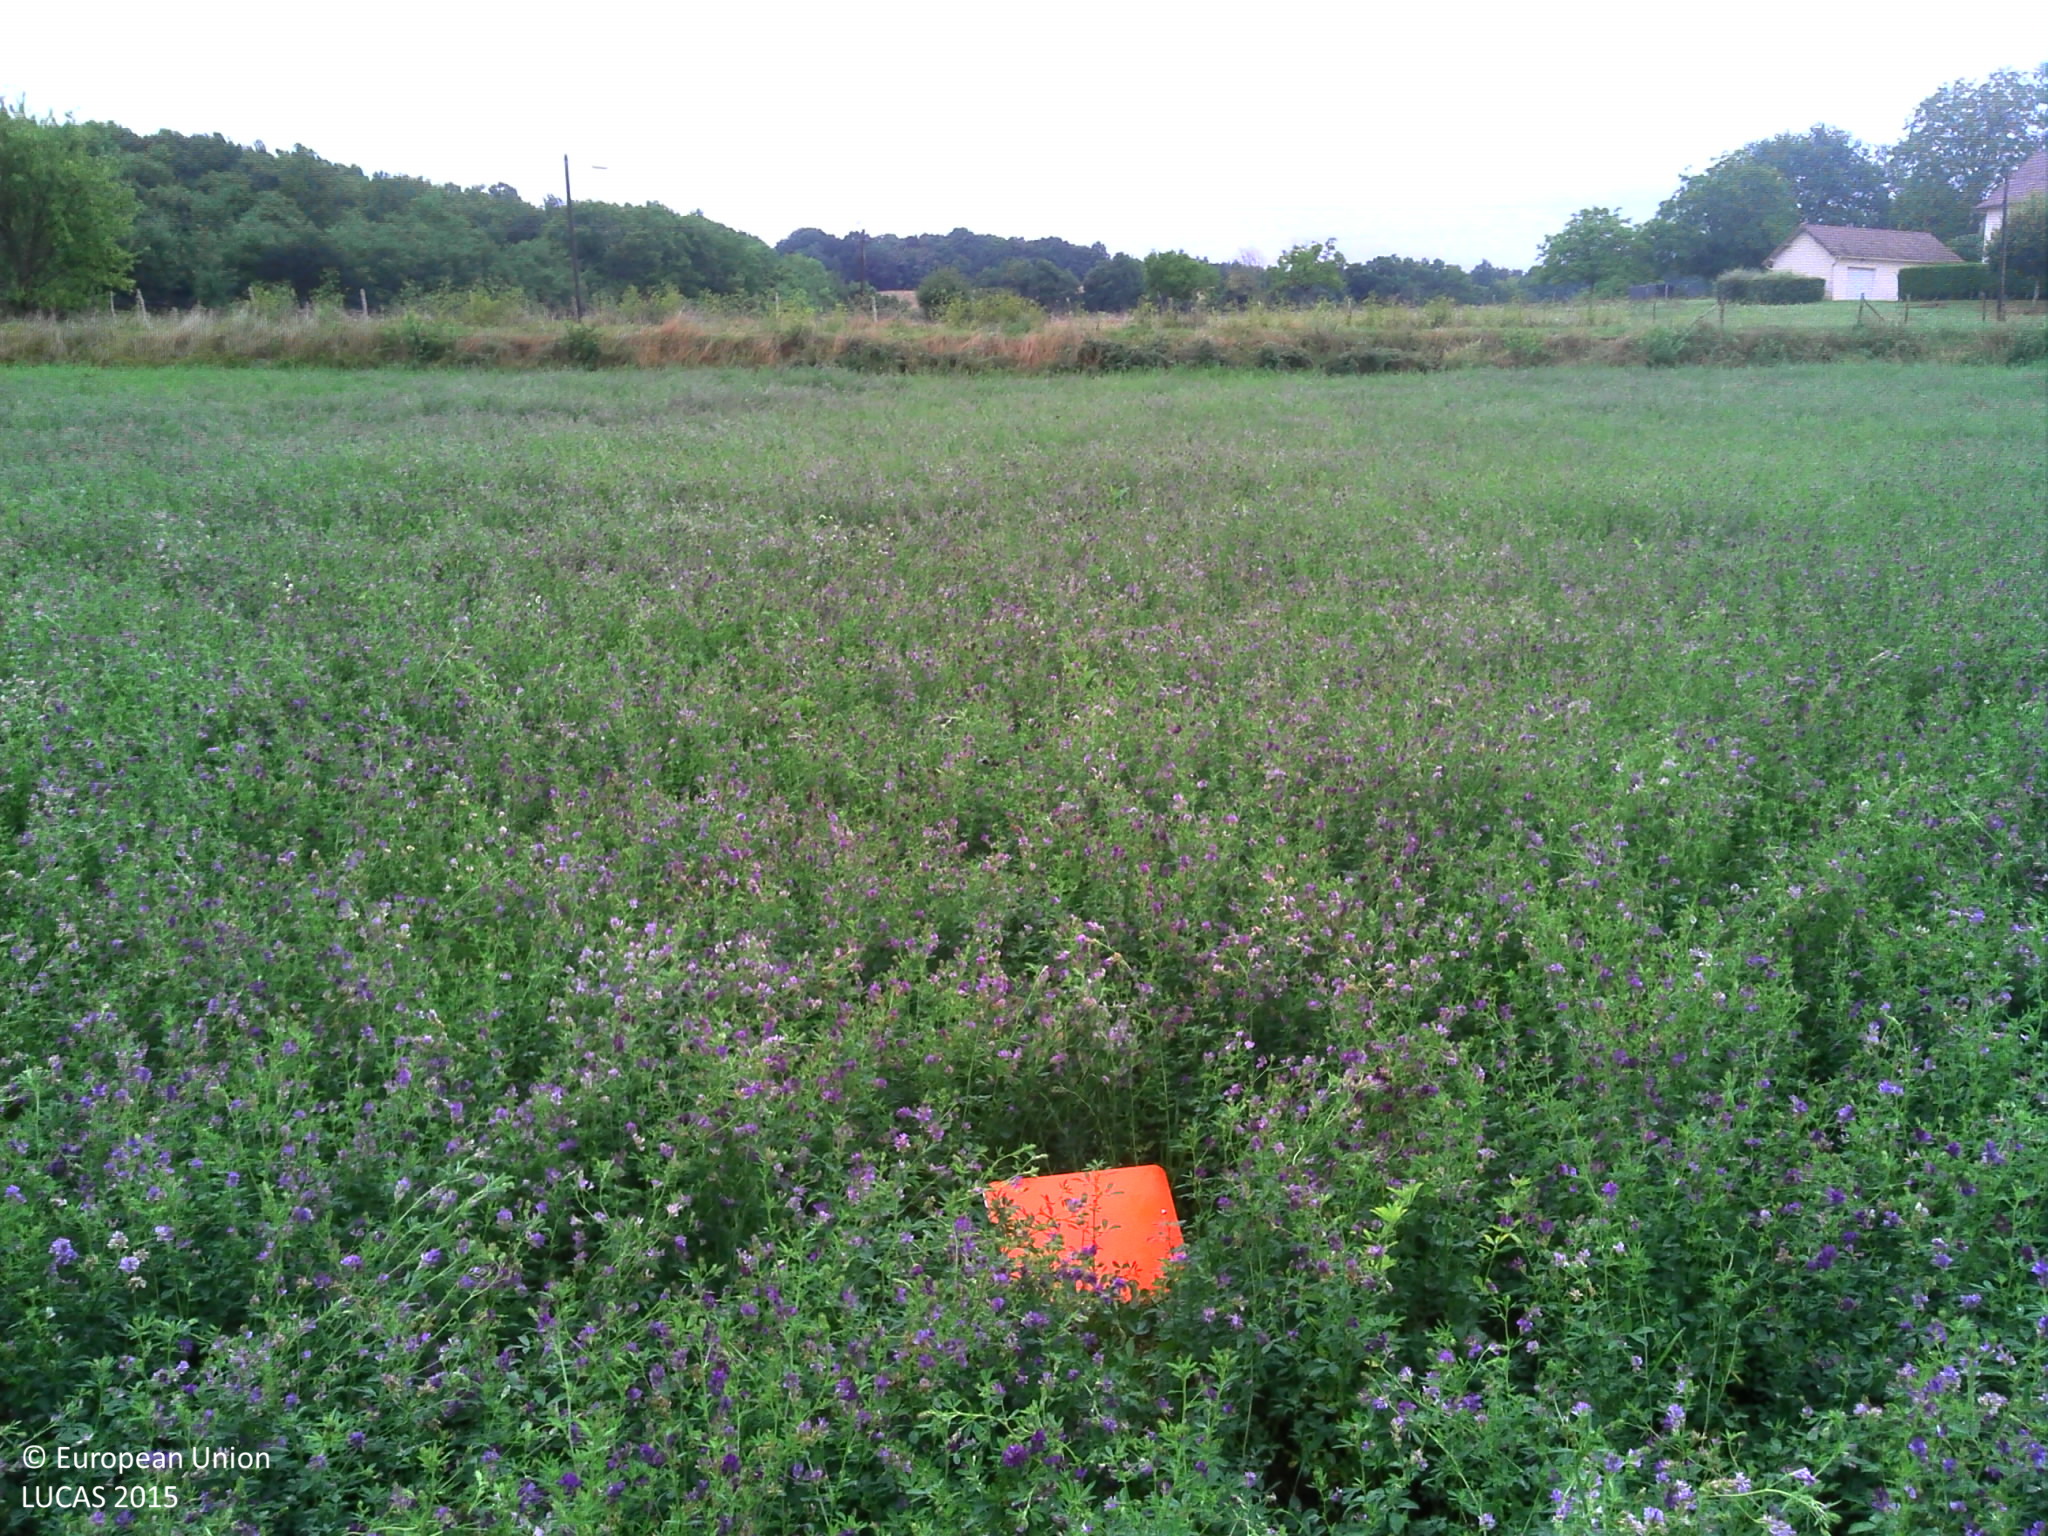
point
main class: Cropland
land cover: Lucerne
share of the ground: > 75 %
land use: Agriculture (excluding fallow land and kitchen gardens)
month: August
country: FR
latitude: 45.5064
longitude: 0.6576
